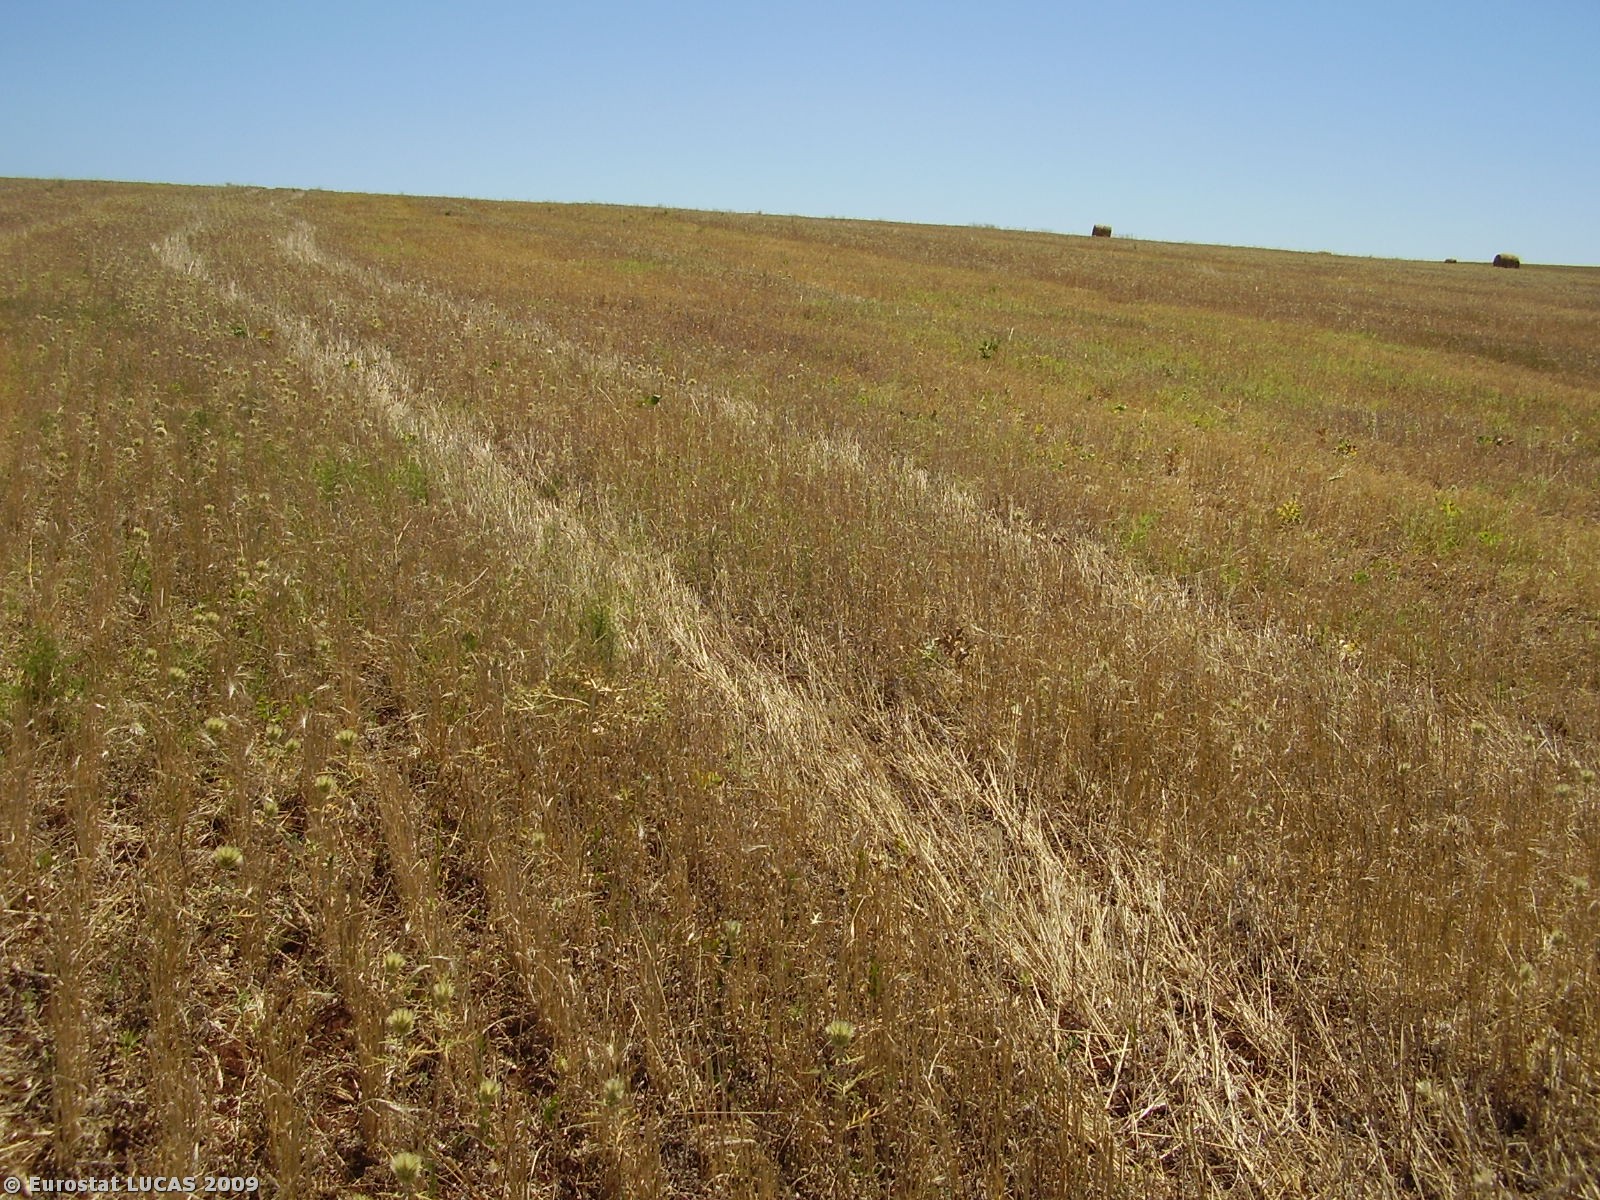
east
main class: Cropland
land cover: Common wheat
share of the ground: > 75 %
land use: Agriculture (excluding fallow land and kitchen gardens)
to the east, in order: Common wheat
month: July
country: PT
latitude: 38.8828
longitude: -7.9017
